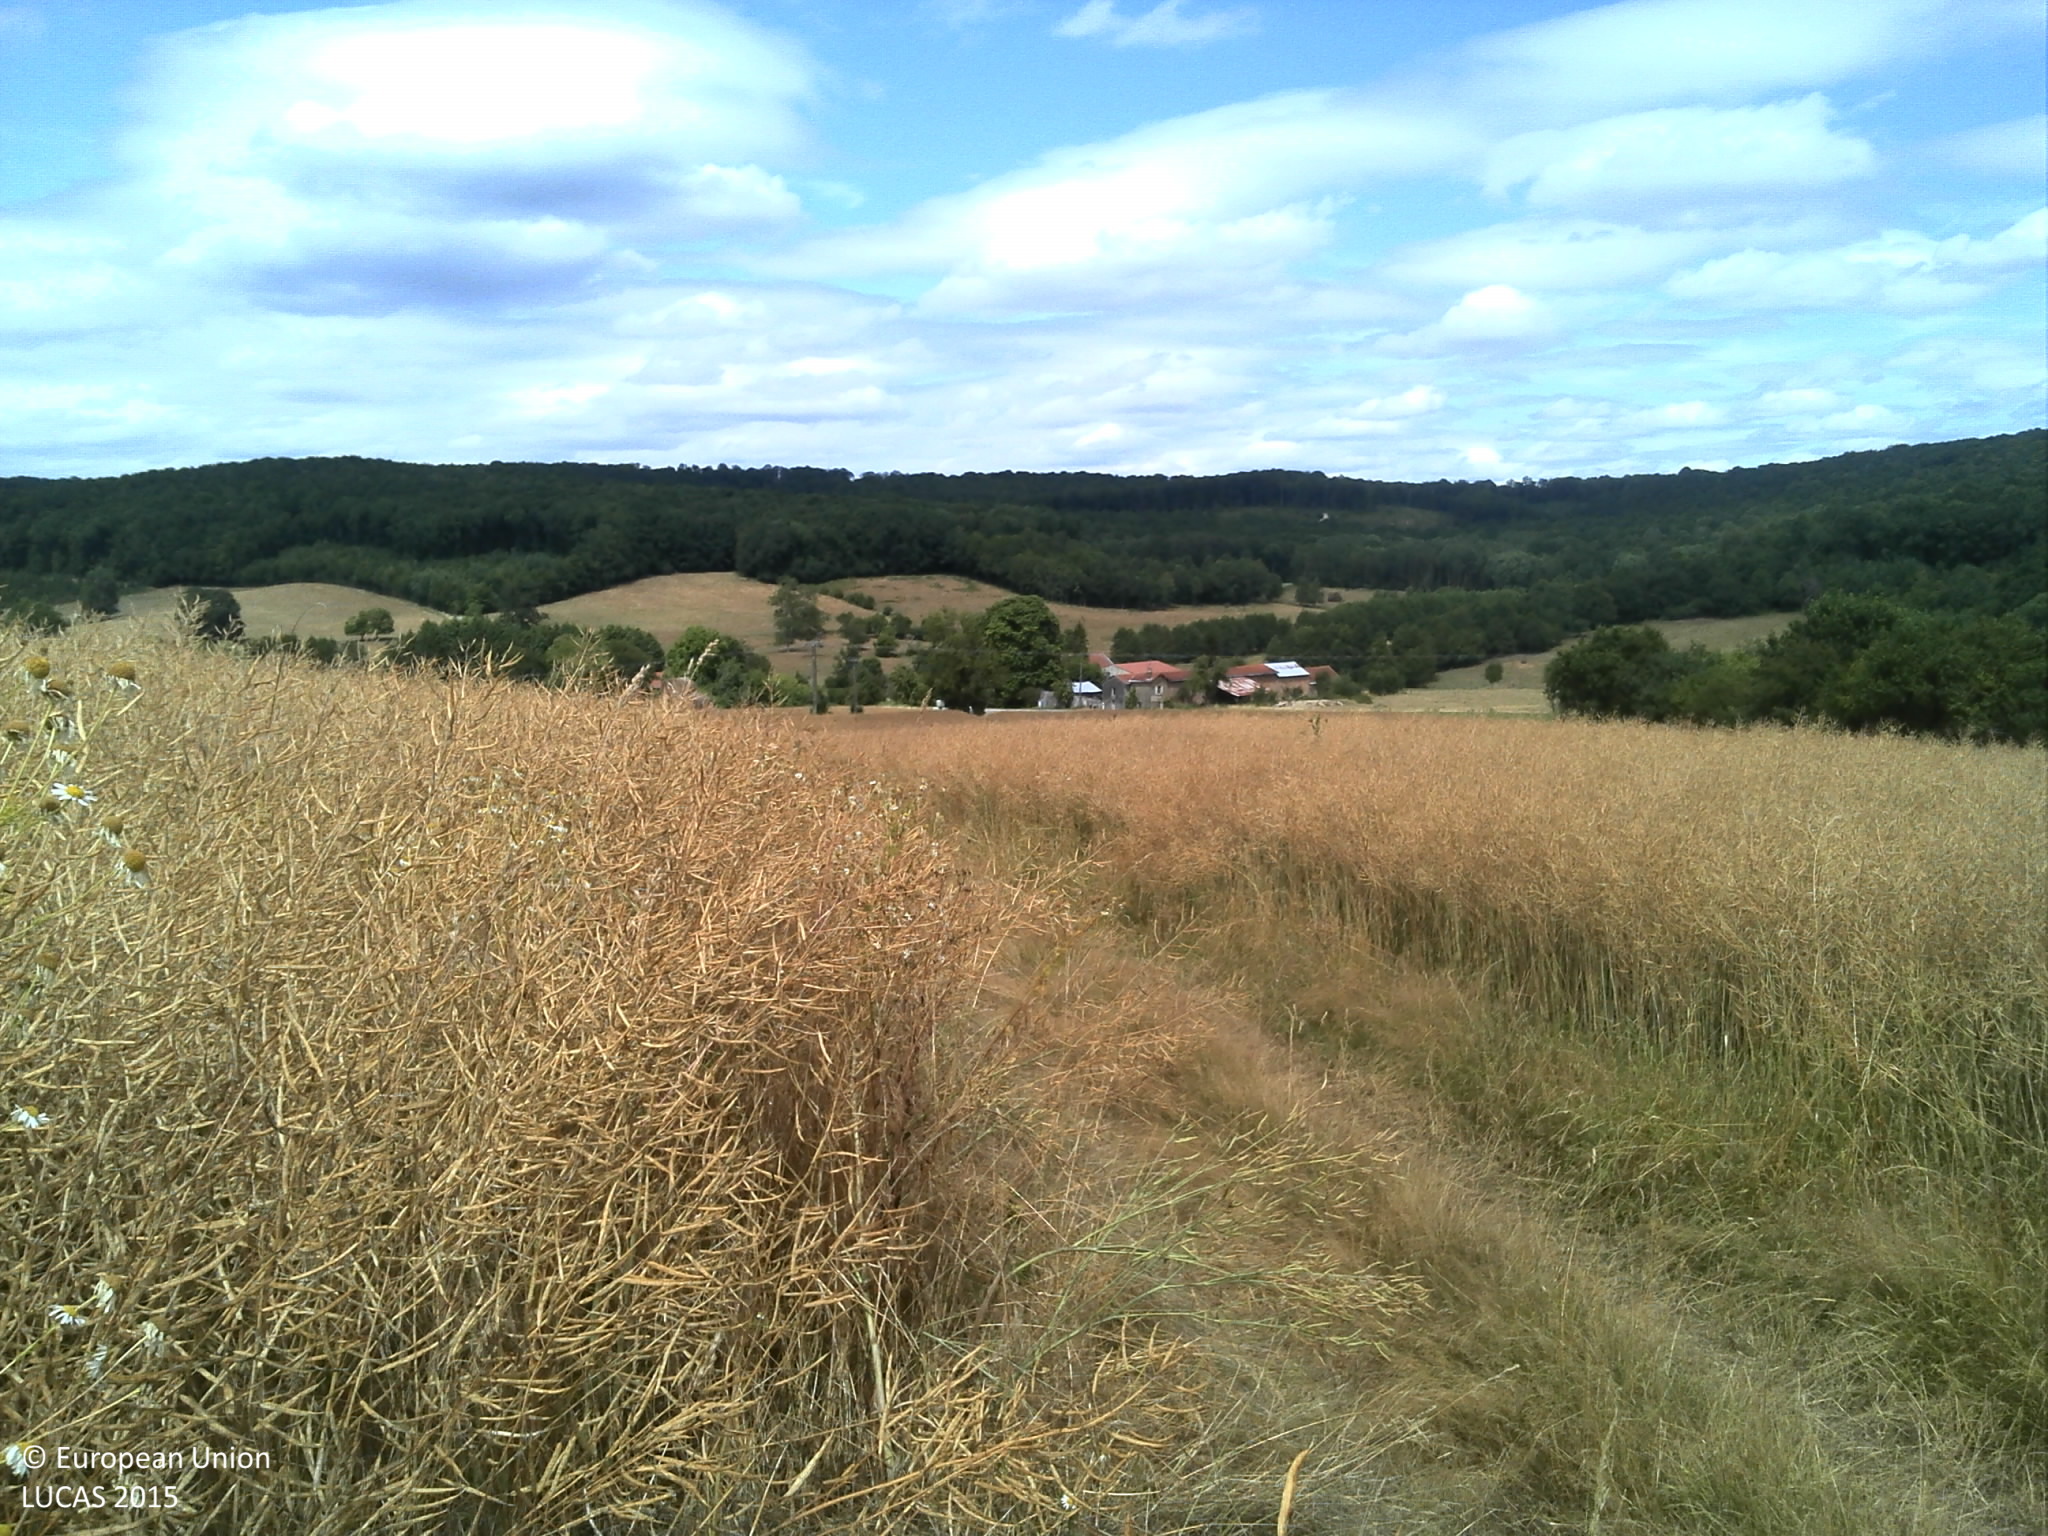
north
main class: Cropland
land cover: Rape and turnip rape
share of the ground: > 75 %
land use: Agriculture (excluding fallow land and kitchen gardens)
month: July
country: FR
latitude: 49.3451
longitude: 4.8080
